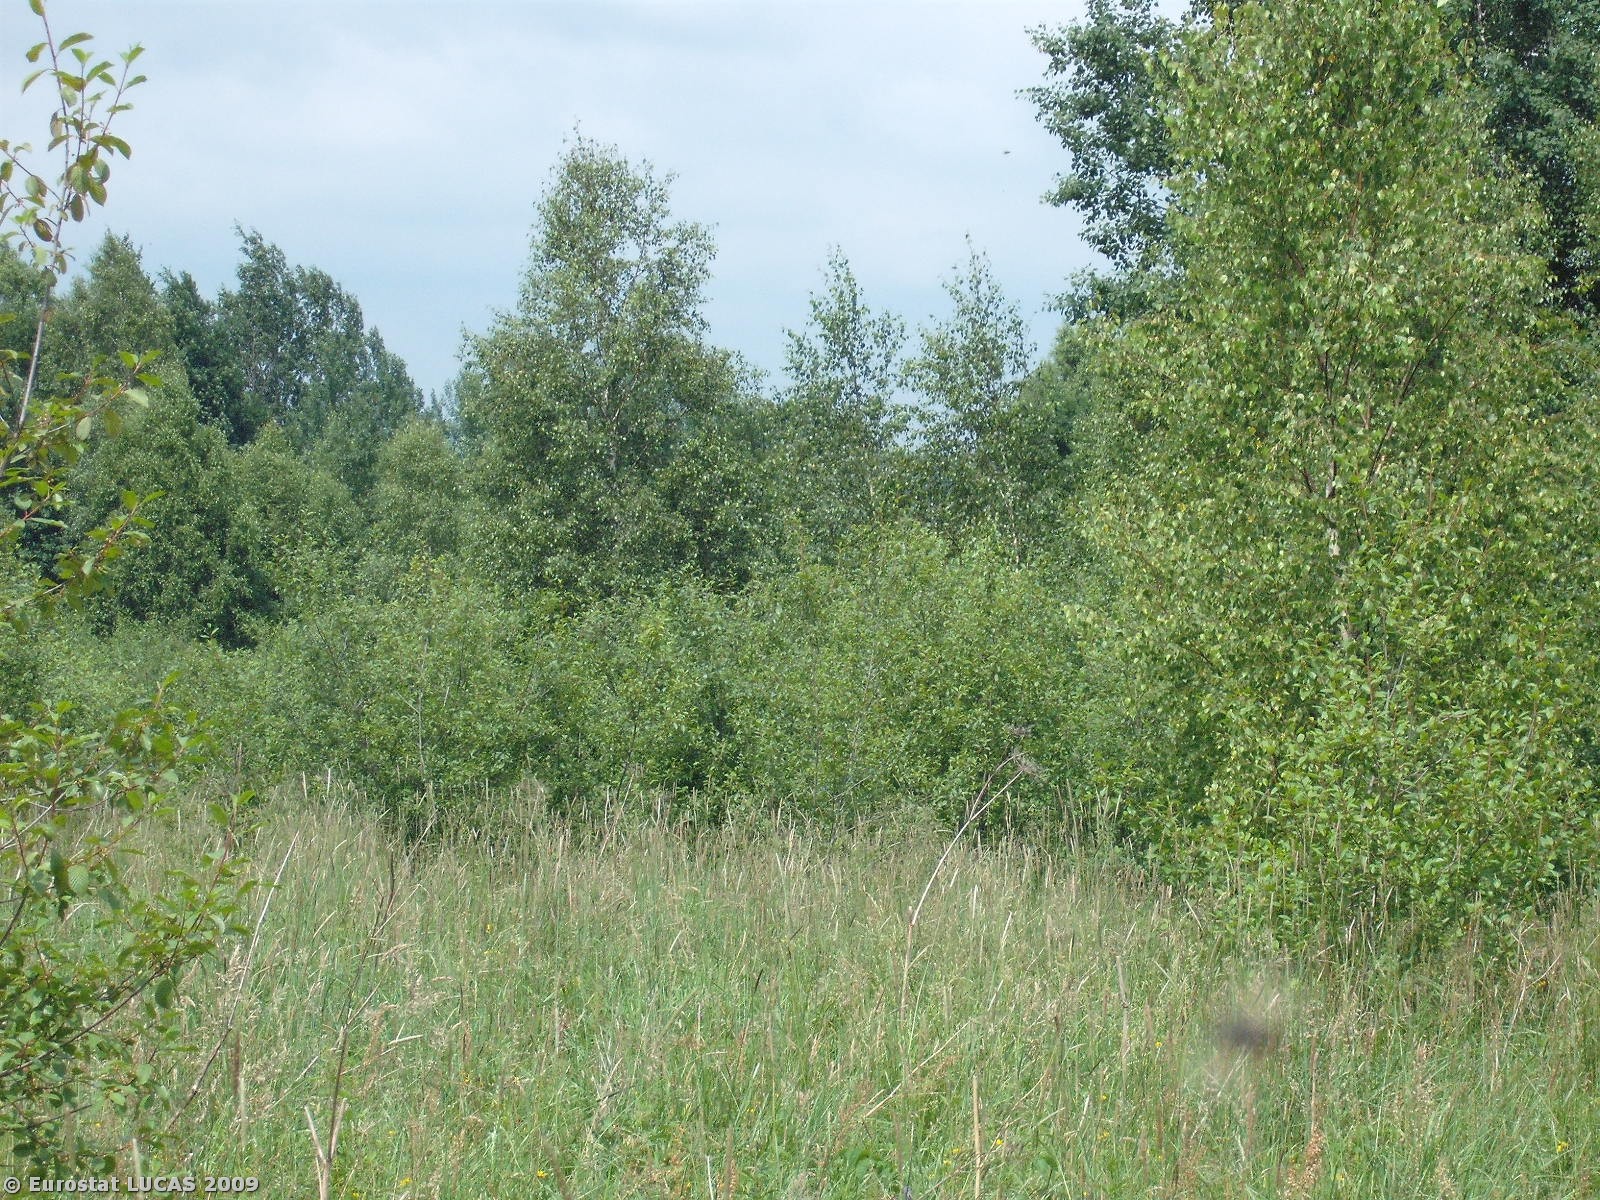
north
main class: Woodland
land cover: Broadleaved woodland
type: mesophytic deciduous forest
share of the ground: 25 - 50 %
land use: Unused
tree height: > 5 m
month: June
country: PL
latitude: 51.2513
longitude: 20.5699
